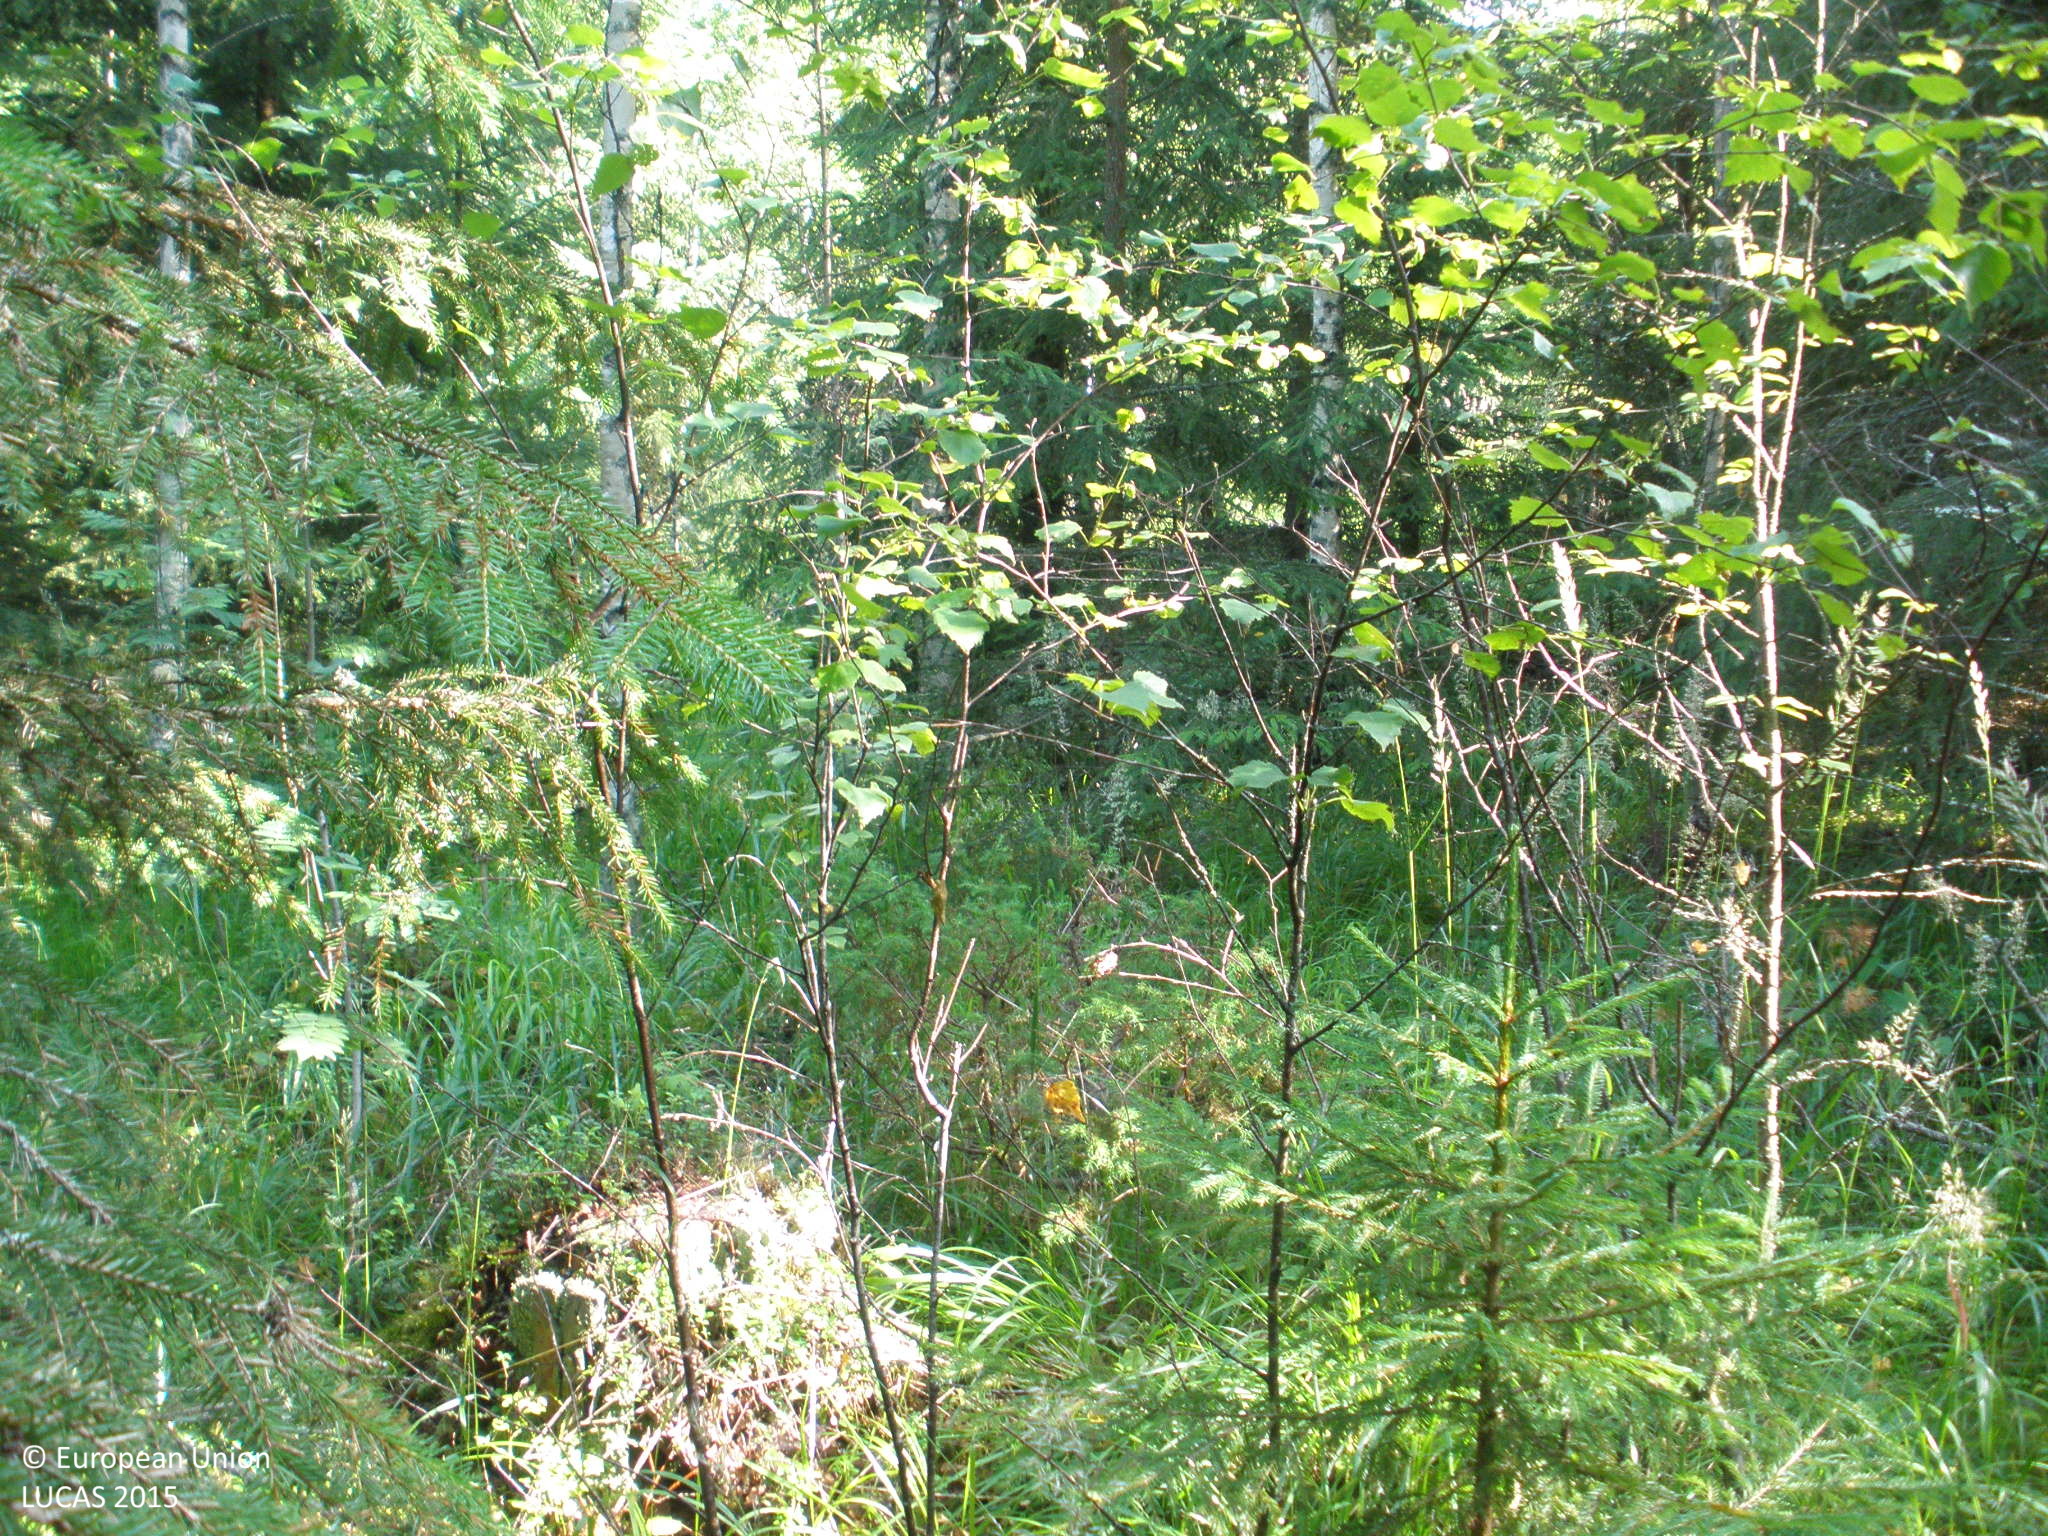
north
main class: Woodland
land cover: Spruce dominated mixed woodland
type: boreal forest
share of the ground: > 75 %
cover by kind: coniferous forest trees 65 %, broadleaved forest trees 25 %, herbaceous plants 10 %
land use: Forestry
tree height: > 5 m
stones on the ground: 10 - 25 %
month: July
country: FI
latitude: 61.1769
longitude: 24.9682
